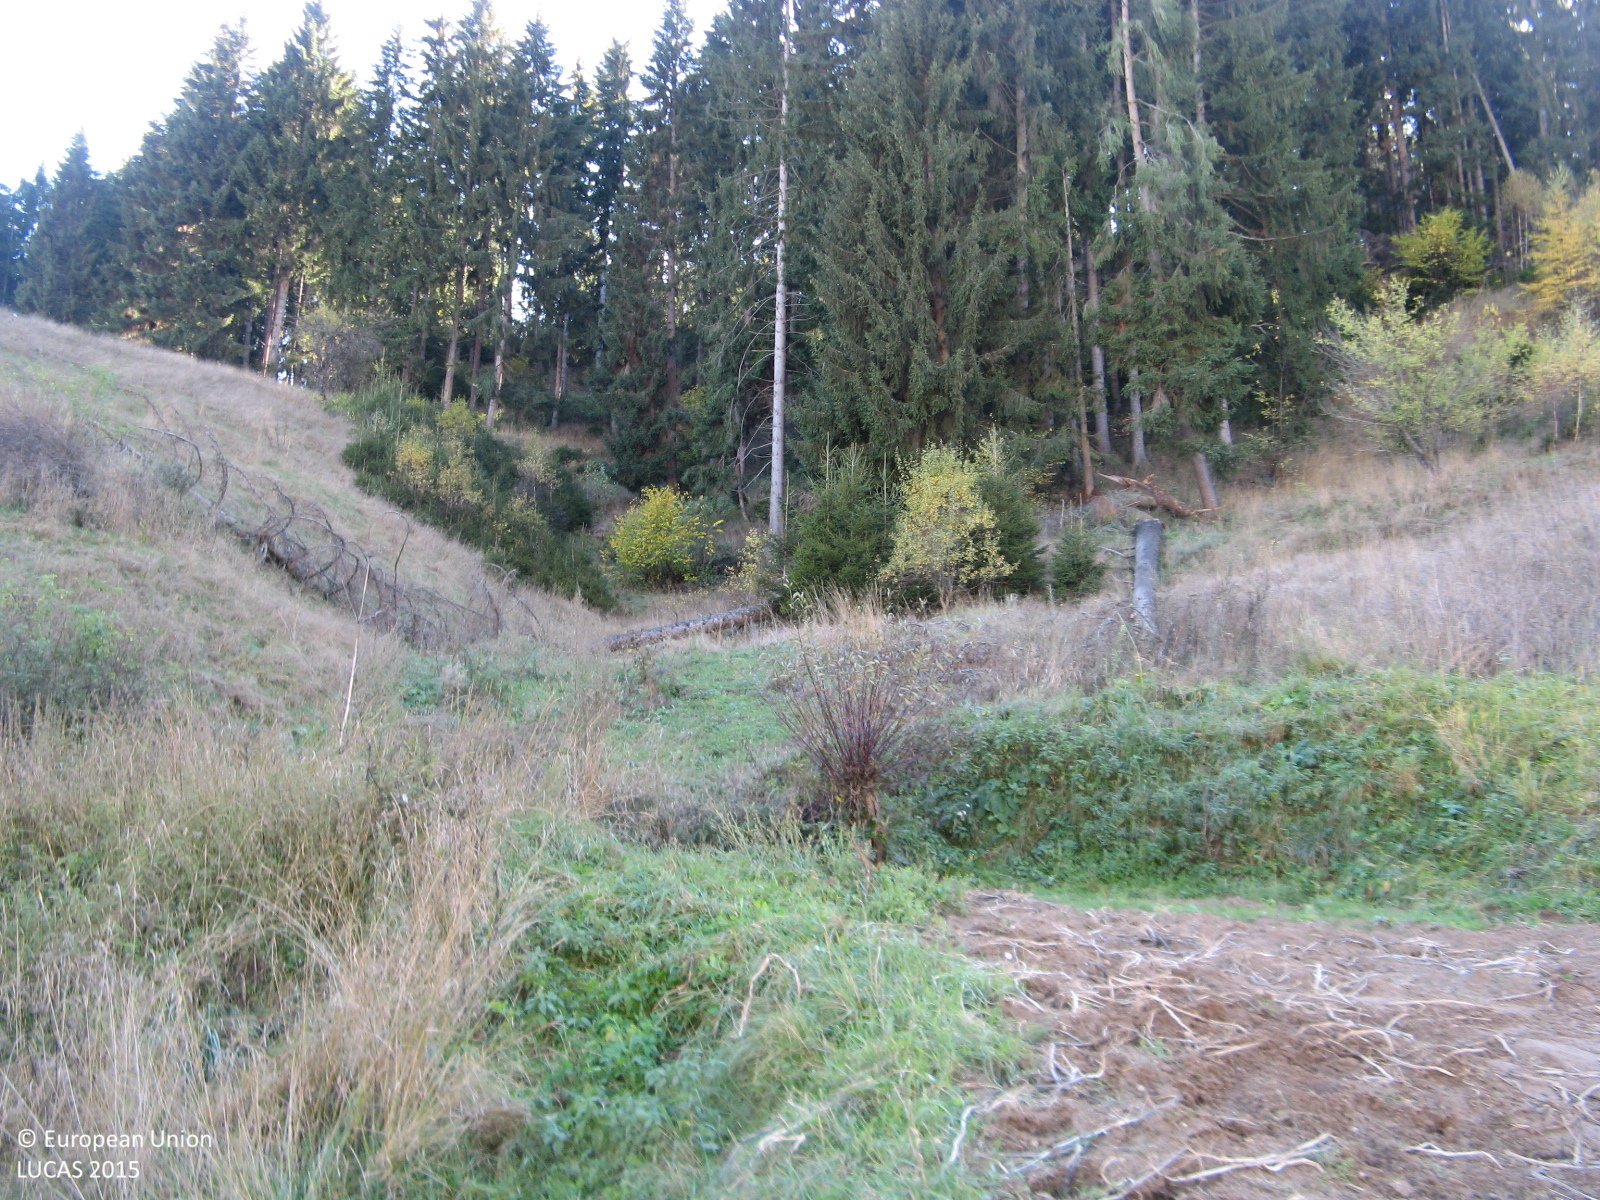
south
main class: Cropland
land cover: Potatoes
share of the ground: < 10 %
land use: Agriculture (excluding fallow land and kitchen gardens)
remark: Harvested field
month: October
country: BG
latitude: 41.7251
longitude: 24.6749
